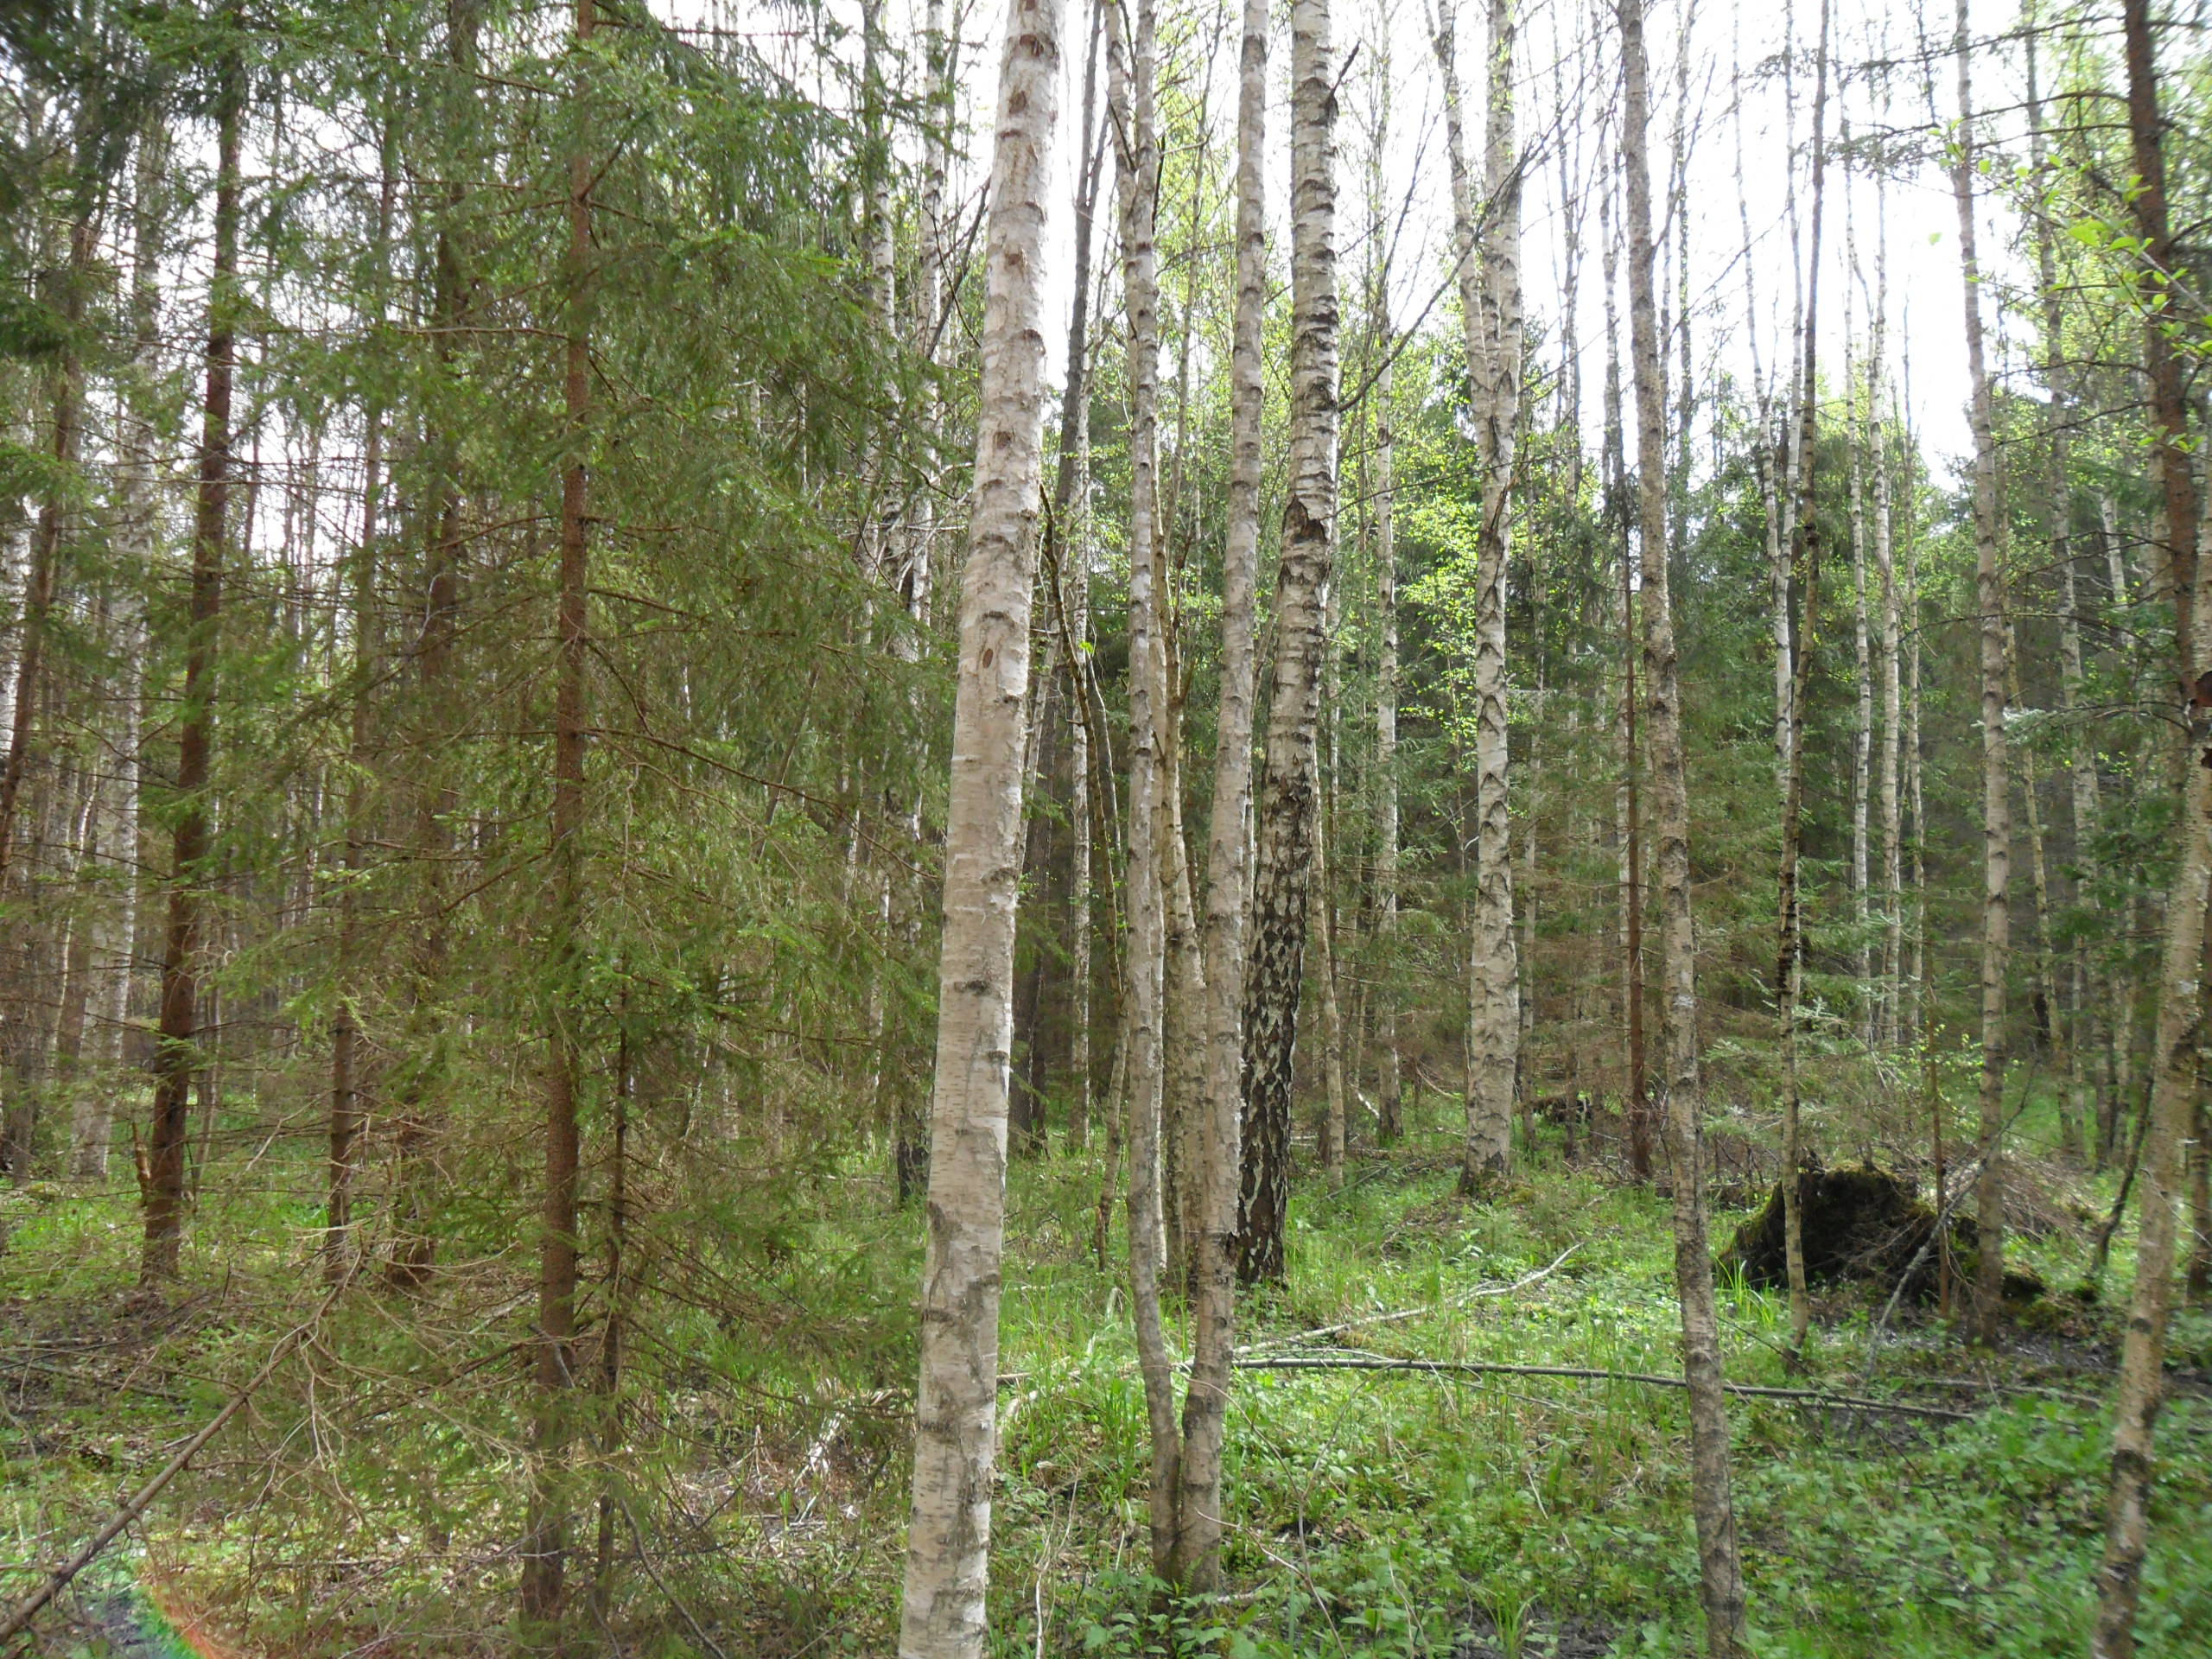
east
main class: Woodland
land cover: Spruce dominated mixed woodland
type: hemiboreal forest and nemoral coniferous forest and mixed broadleaved-coniferous forest
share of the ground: > 75 %
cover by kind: coniferous forest trees 45 %, broadleaved forest trees 30 %, herbaceous plants 20 %, shrubs 5 %
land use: Forestry
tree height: > 5 m
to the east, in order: Spruce dominated mixed woodland; Ditches and canals; Abandoned hedges; Tracks; Grassland with sparse tree/shrub cover
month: May
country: LV
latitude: 57.2969
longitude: 22.9558
